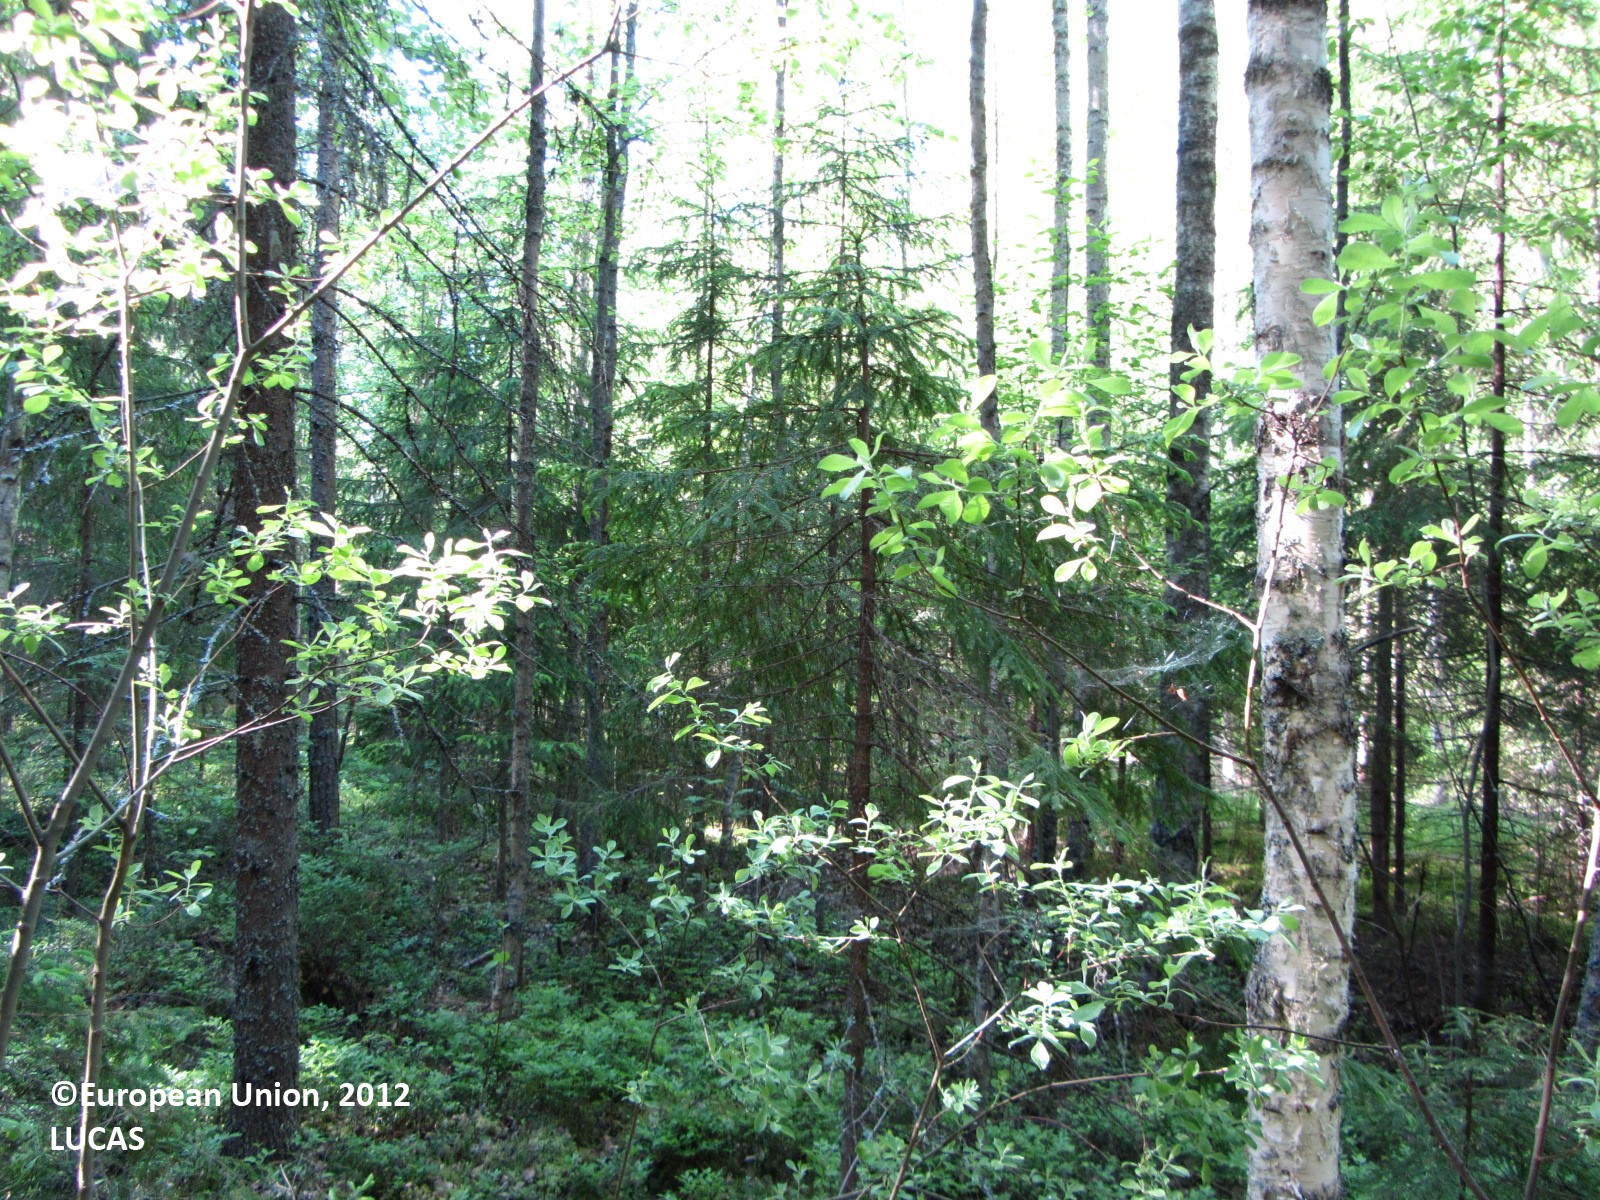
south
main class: Woodland
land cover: Spruce dominated coniferous woodland
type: boreal forest
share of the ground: 50 - 75 %
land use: Forestry
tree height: > 5 m
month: June
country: FI
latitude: 61.9639
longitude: 24.6490
